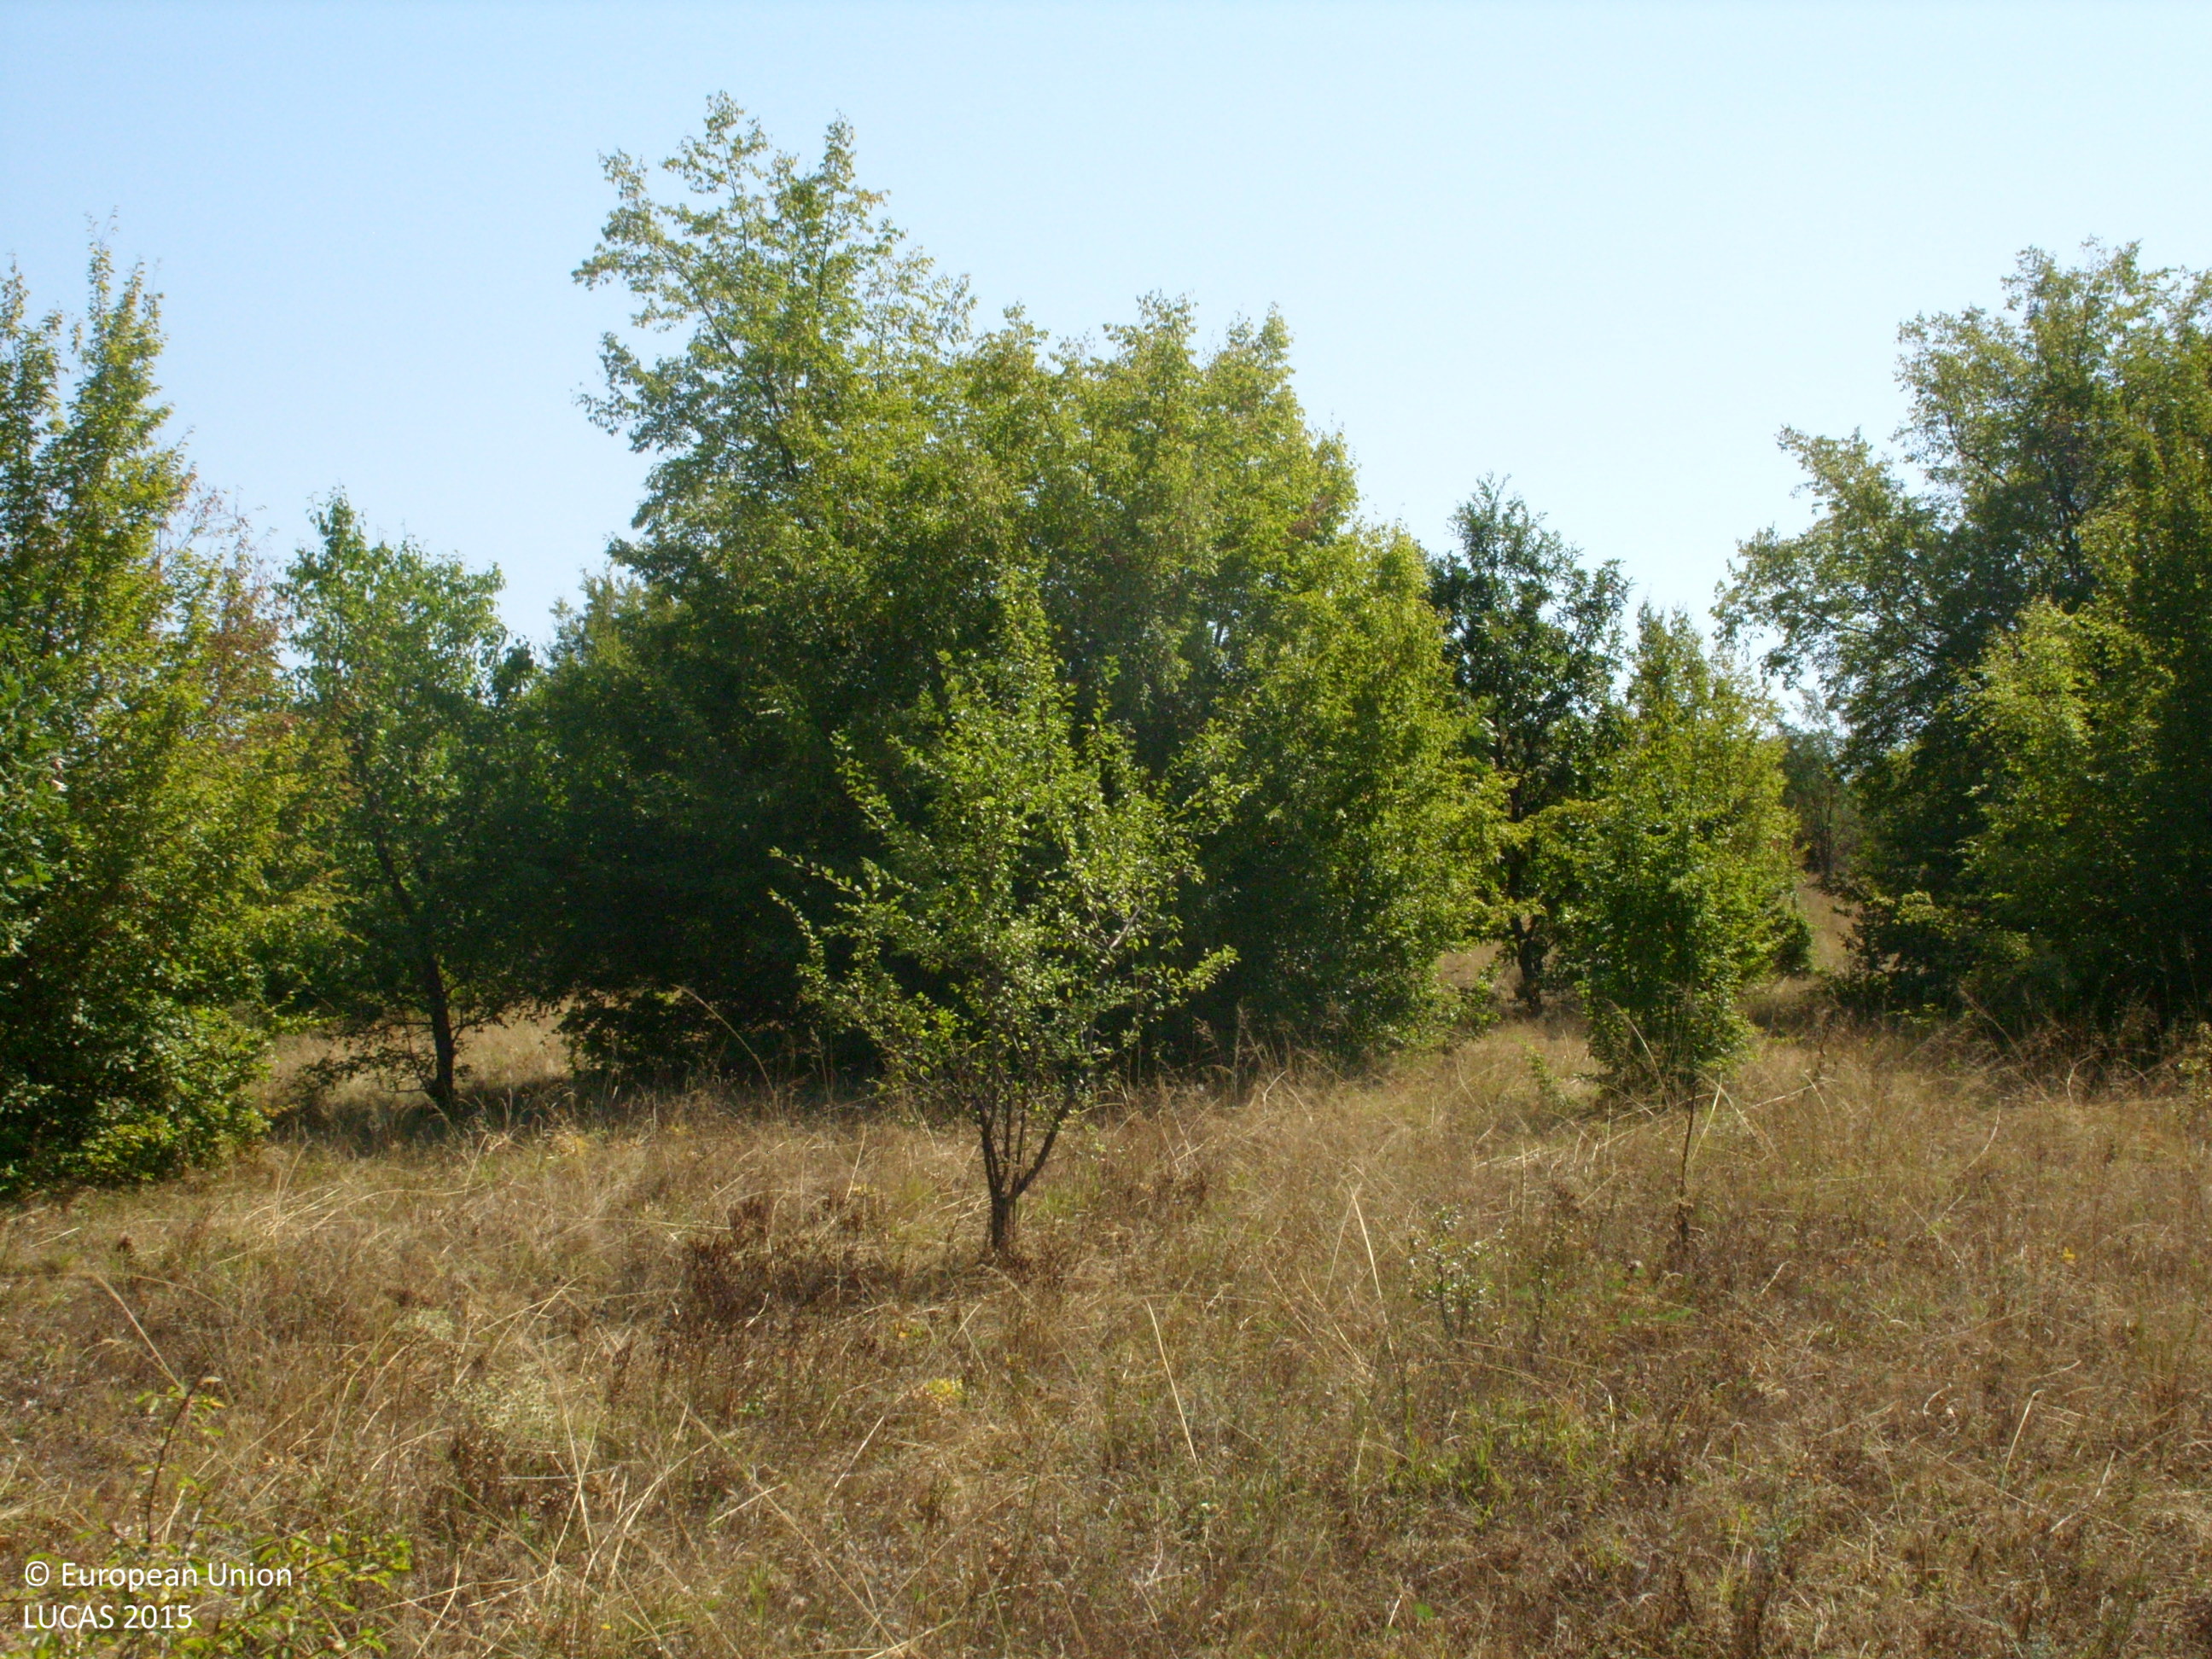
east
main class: Grassland
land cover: Grassland with sparse tree/shrub cover
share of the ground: > 75 %
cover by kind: herbaceous plants 85 %, shrubs 10 %, broadleaved forest trees 5 %
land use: Semi-natural and natural areas not in use
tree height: < 5 m
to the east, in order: Grassland with sparse tree/shrub cover; Broadleaved woodland; Paved roads, cycling and walking lanes; Broadleaved woodland
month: August
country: BG
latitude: 42.4142
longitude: 25.0929
